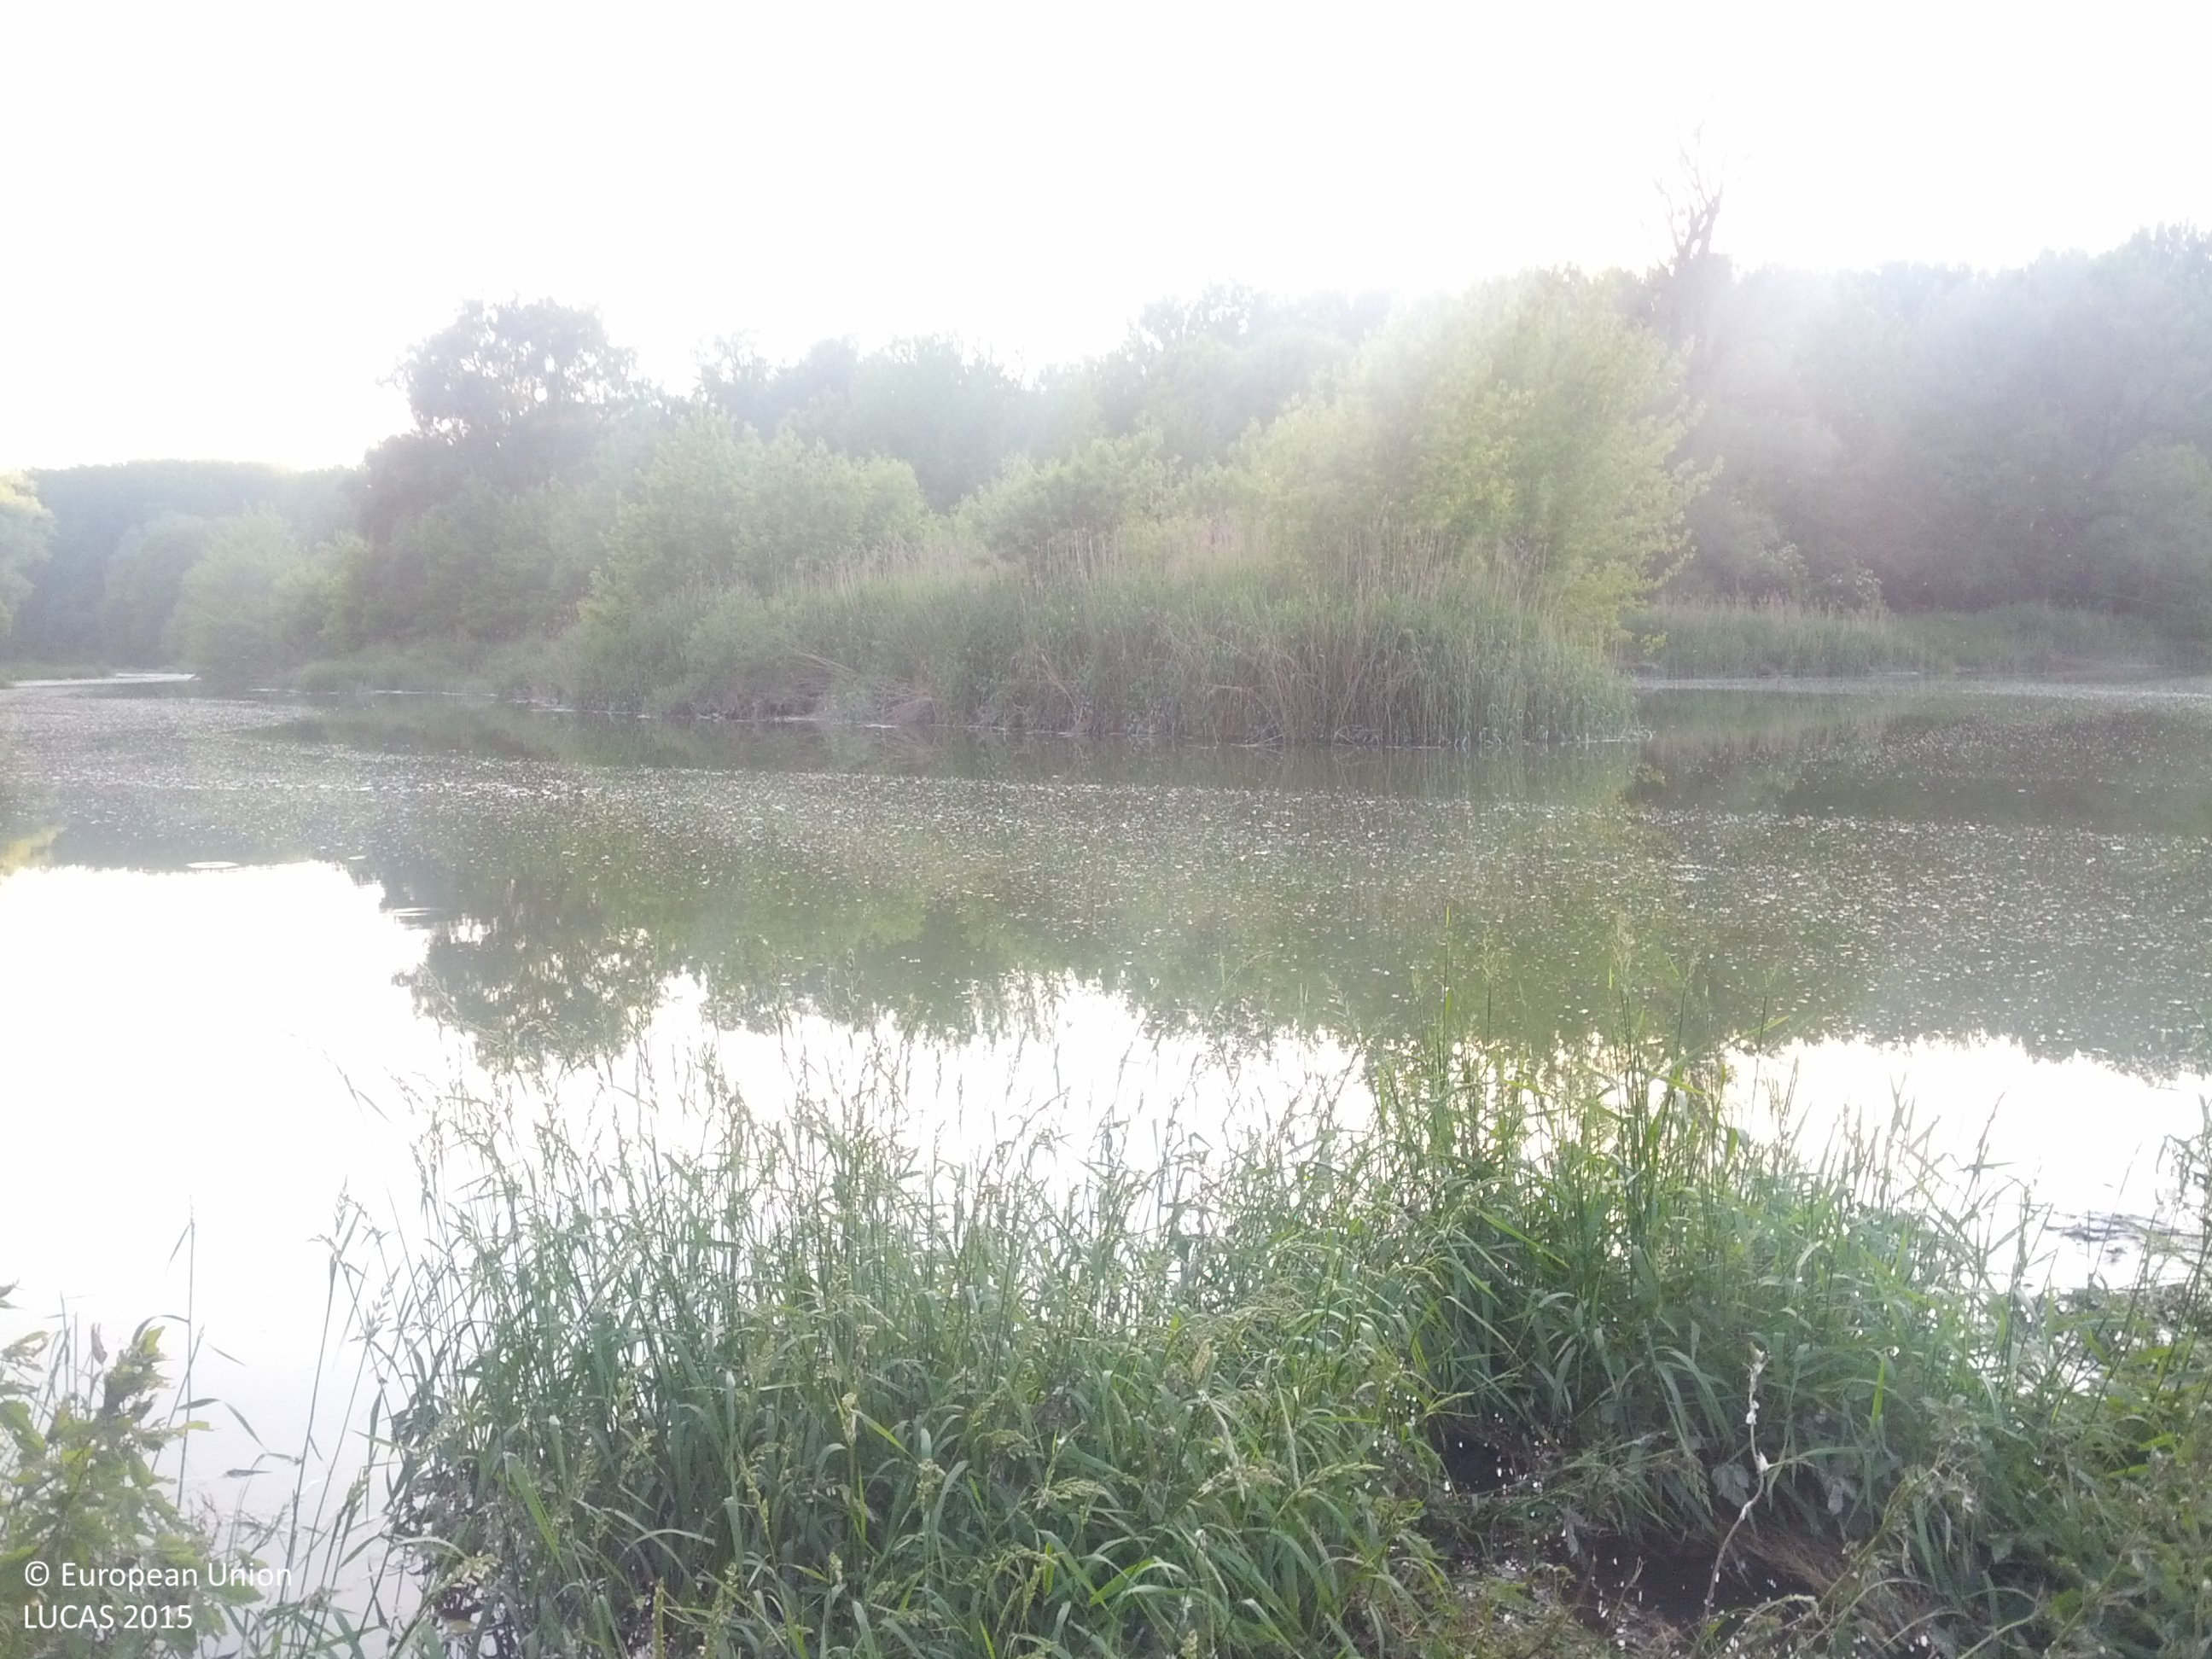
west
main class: Shrubland
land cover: Shrubland with sparse tree cover
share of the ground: 50 - 75 %
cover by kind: shrubs 55 %, herbaceous plants 30 %, broadleaved forest trees 5 %, consolidated bare surface 5 %, unconsolidated bare surface 5 %
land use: Semi-natural and natural areas not in use
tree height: > 5 m
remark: Temporary flooded
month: May
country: AT
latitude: 48.1191
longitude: 16.8443
